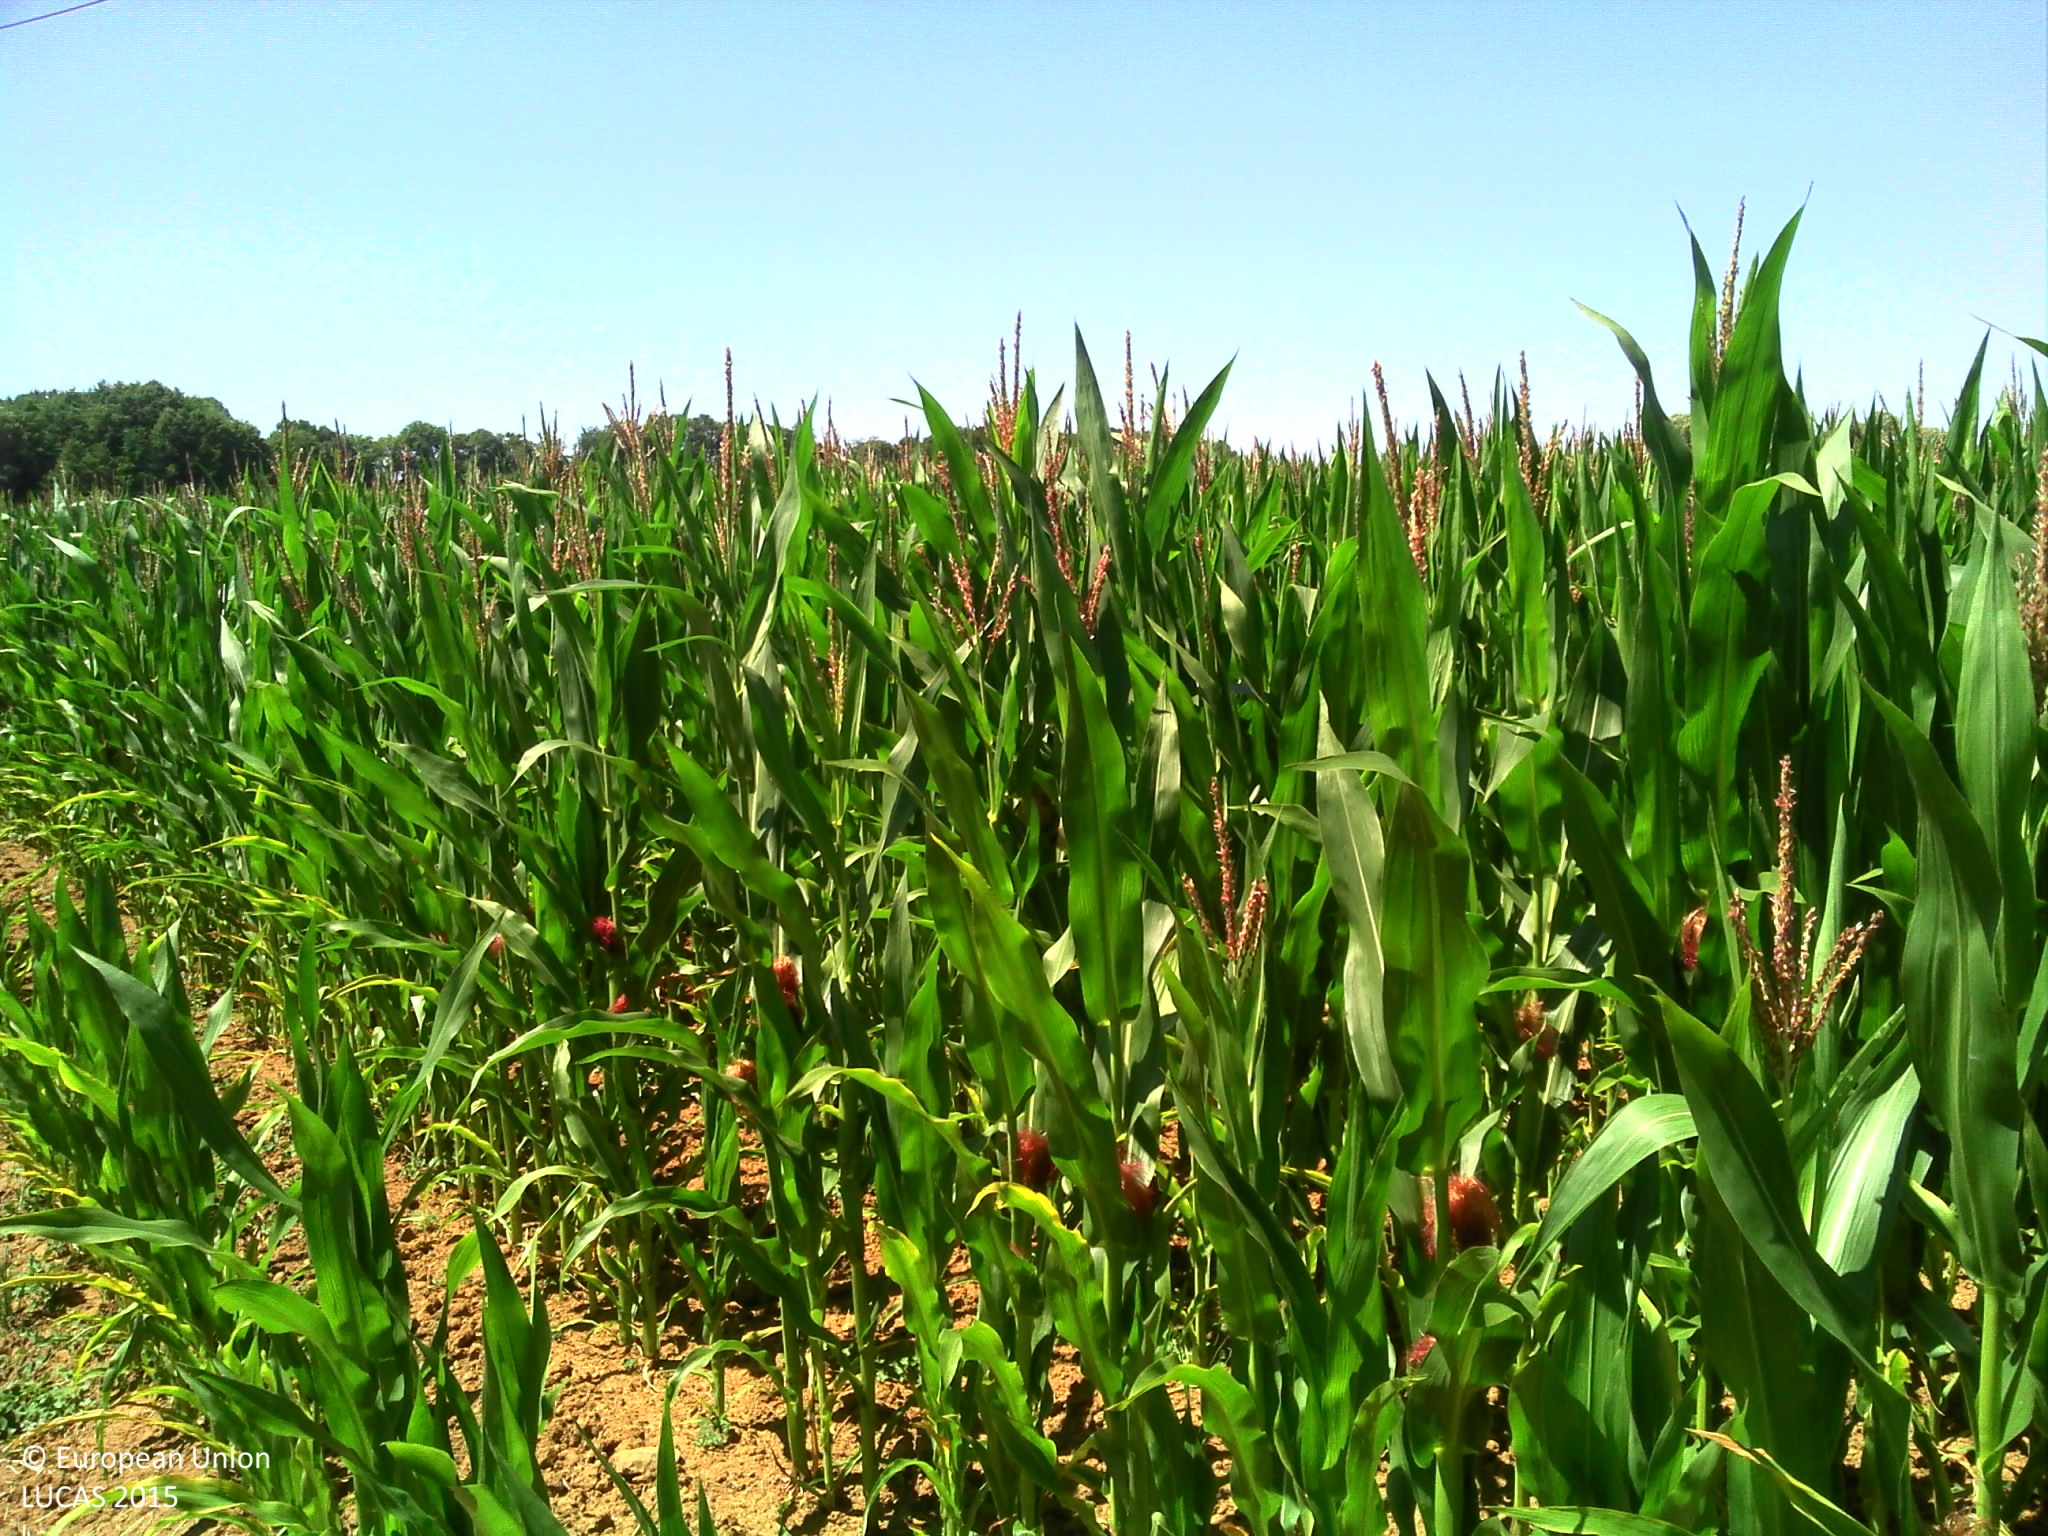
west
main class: Cropland
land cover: Maize
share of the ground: > 75 %
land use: Agriculture (excluding fallow land and kitchen gardens)
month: July
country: FR
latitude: 48.8954
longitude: 6.1669
